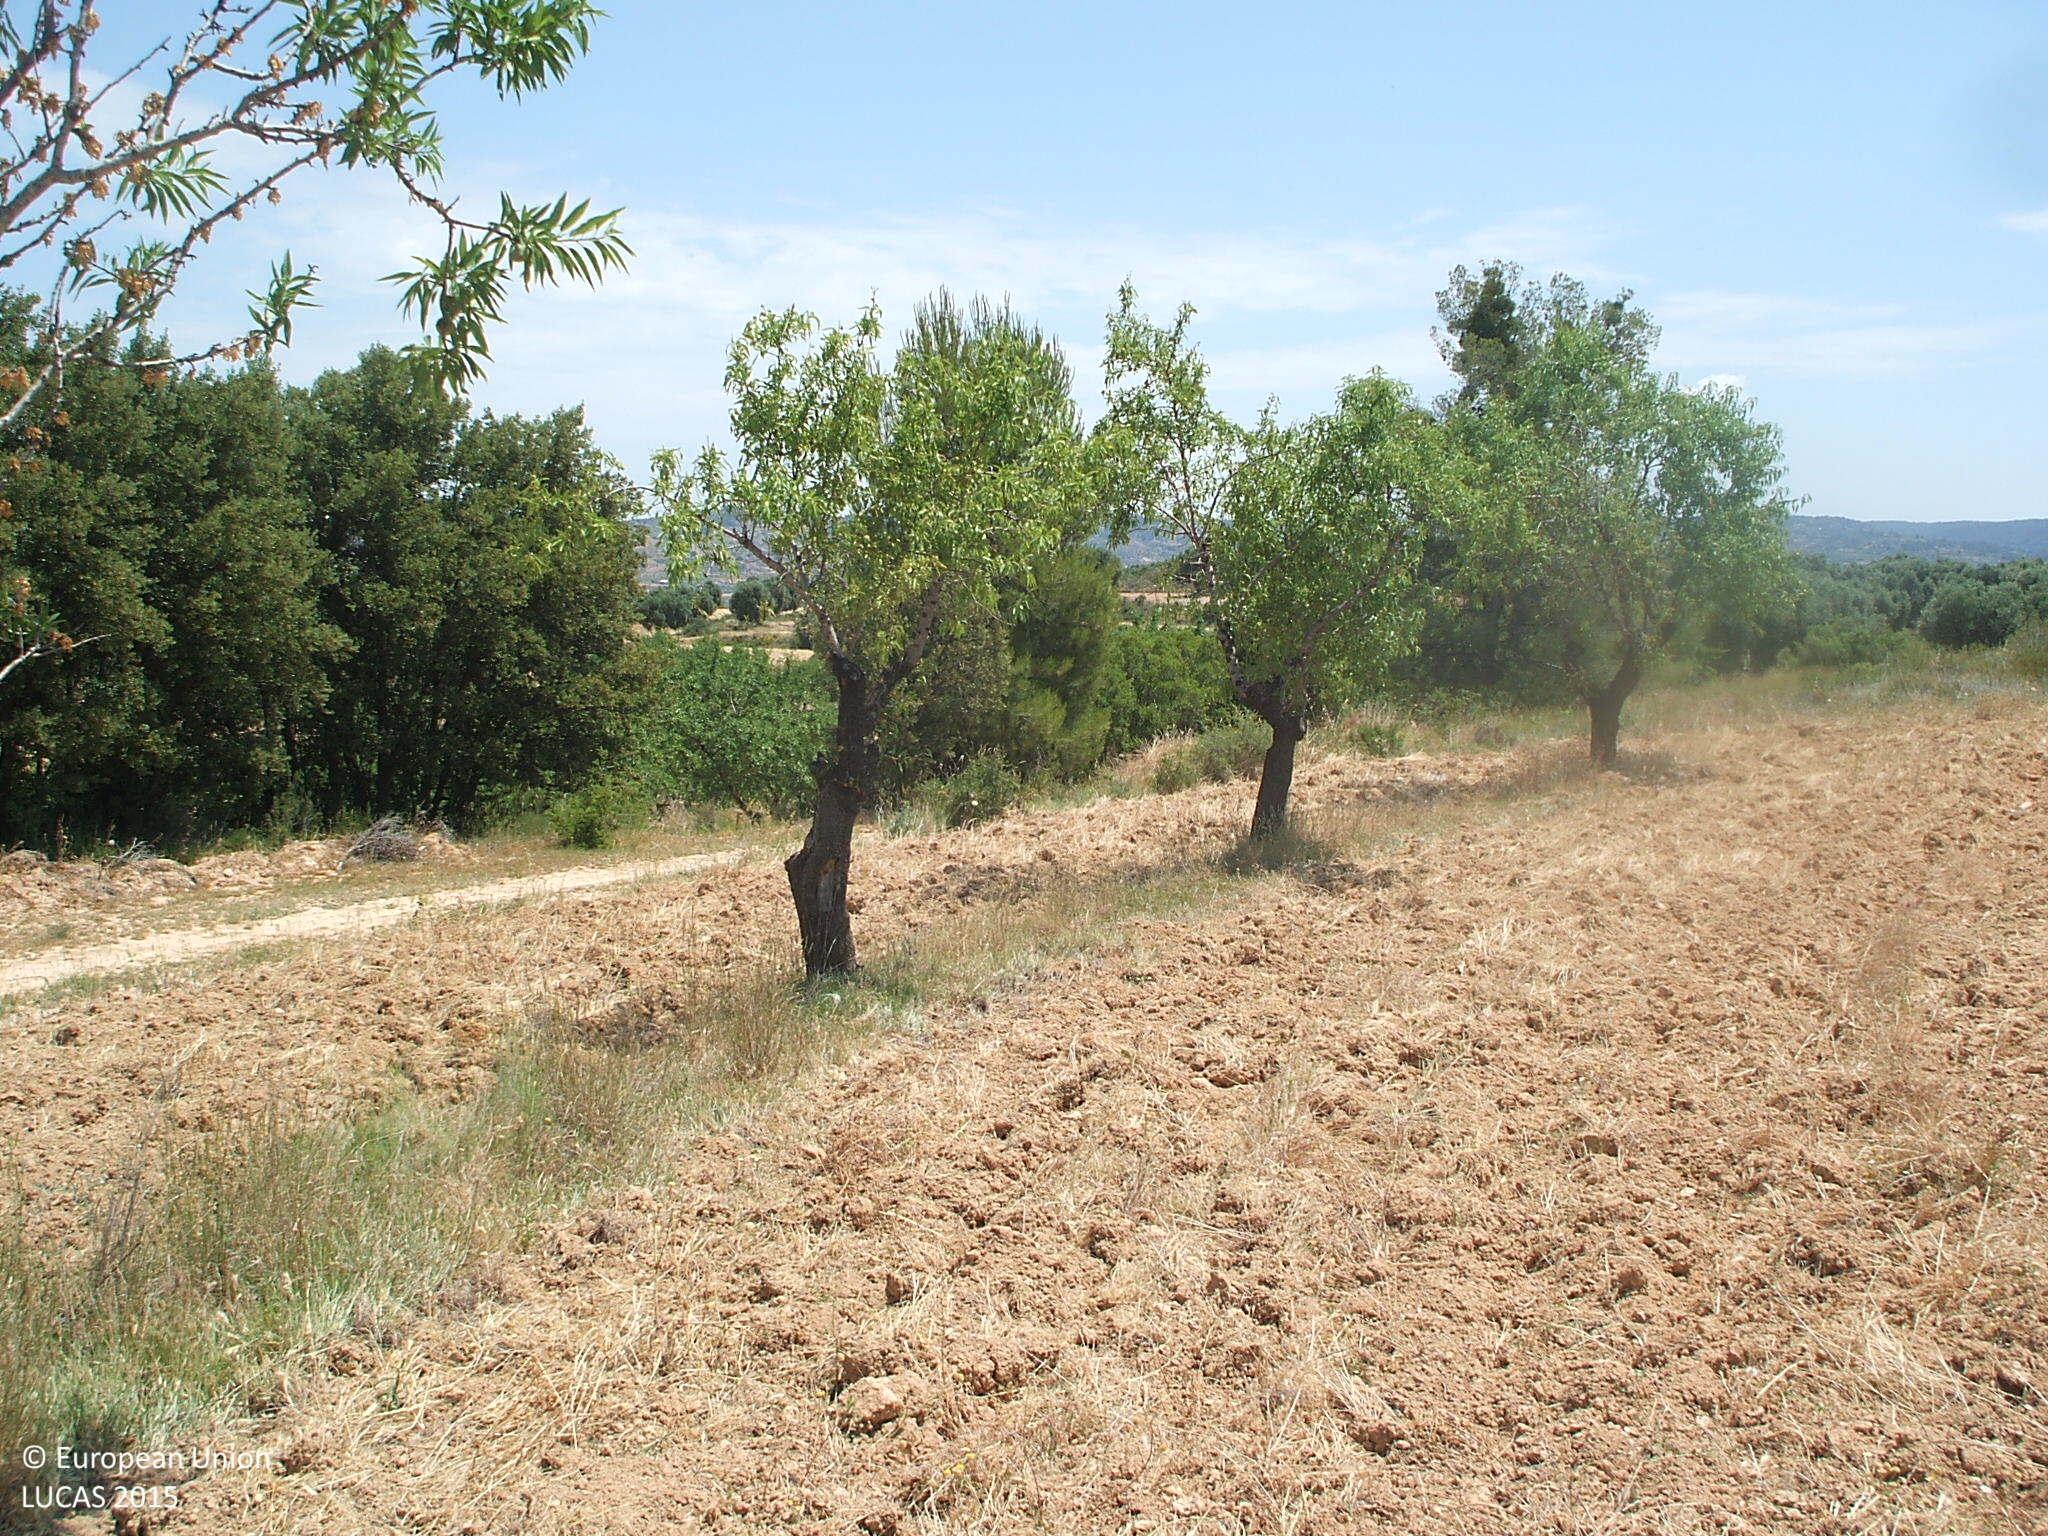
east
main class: Cropland
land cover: Nuts trees
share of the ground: 10 - 25 %
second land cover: Other bare soil
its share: > 75 %
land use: Agriculture (excluding fallow land and kitchen gardens)
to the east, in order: Nuts trees; Other bare soil; Grass margins; Broadleaved woodland; Nuts trees; Shruby margins; Nuts trees; Grass margins; Barley; Shruby margins; Dry stone walls; Barley; Shruby margins; Olive groves
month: June
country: ES
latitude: 40.9271
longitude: -0.1162
